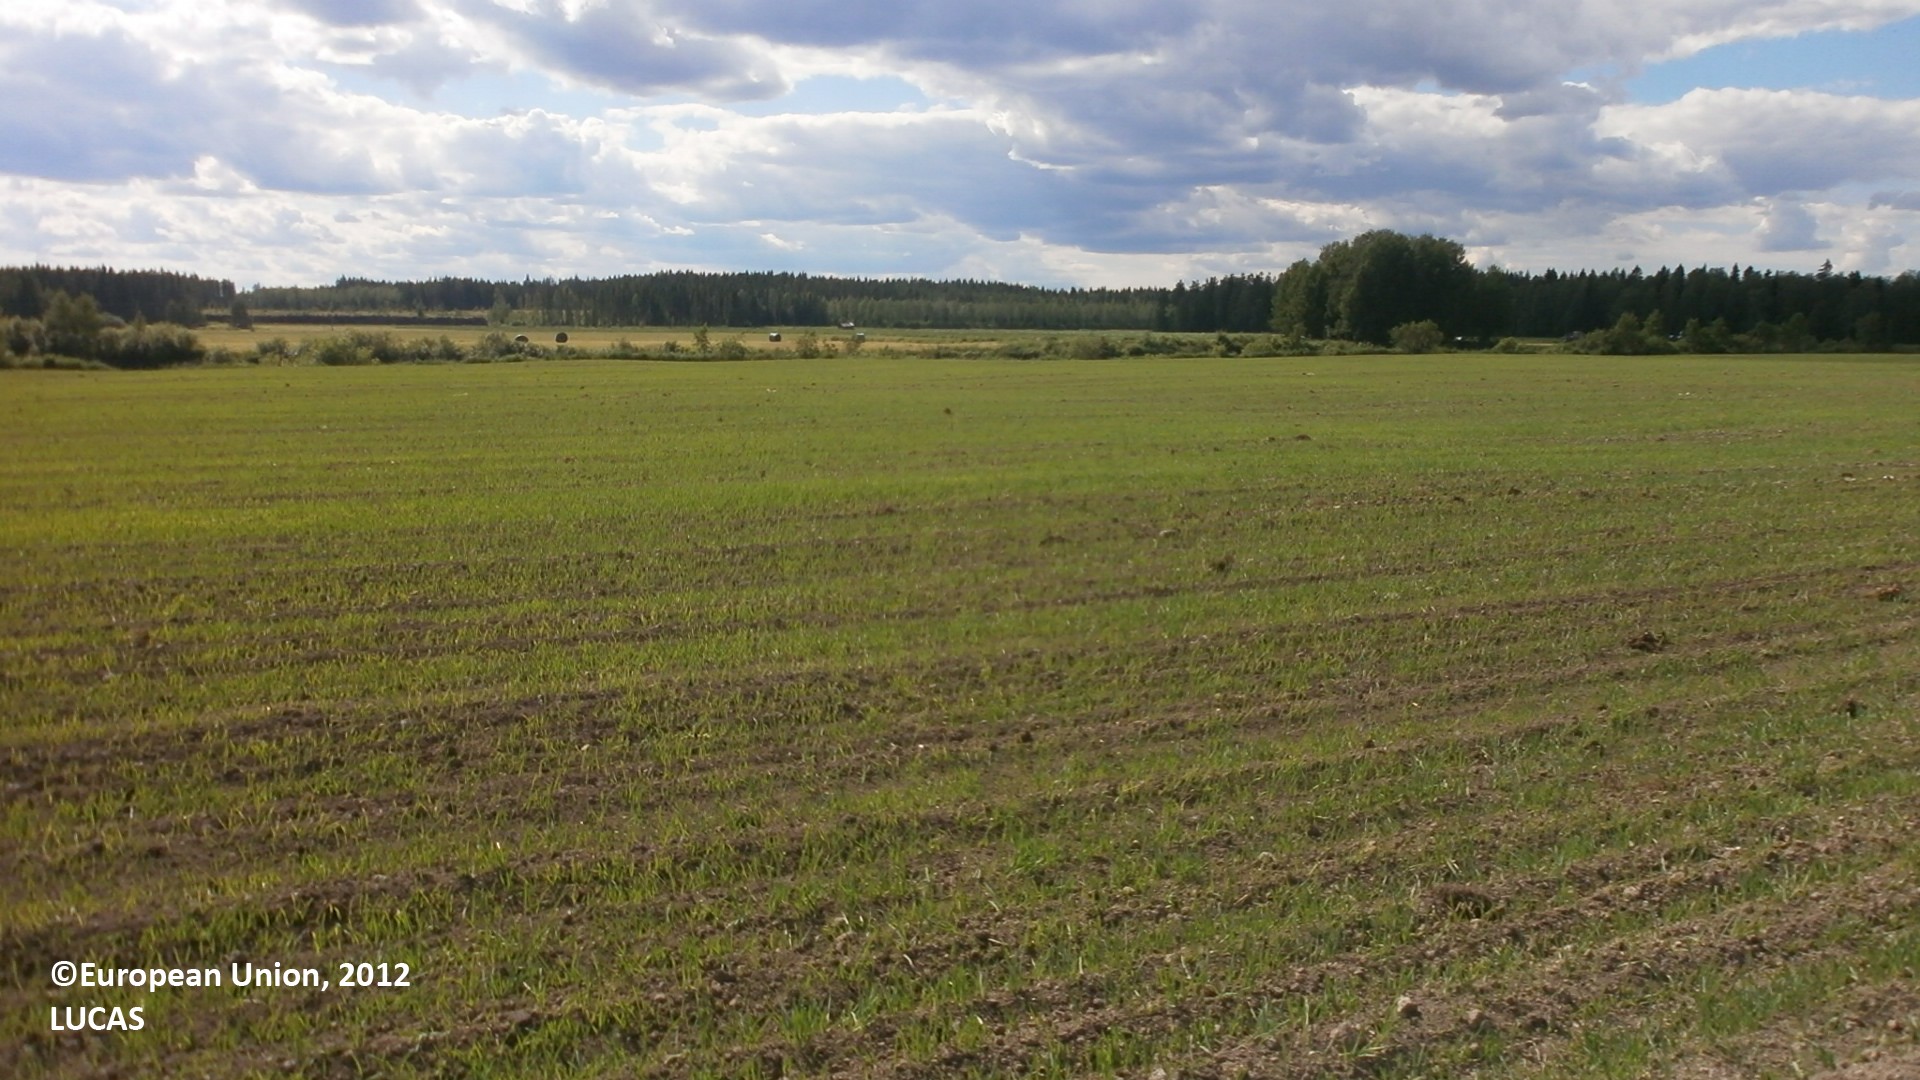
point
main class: Cropland
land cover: Oats
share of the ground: 10 - 25 %
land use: Agriculture (excluding fallow land and kitchen gardens)
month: July
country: FI
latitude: 64.0173
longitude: 24.7481
